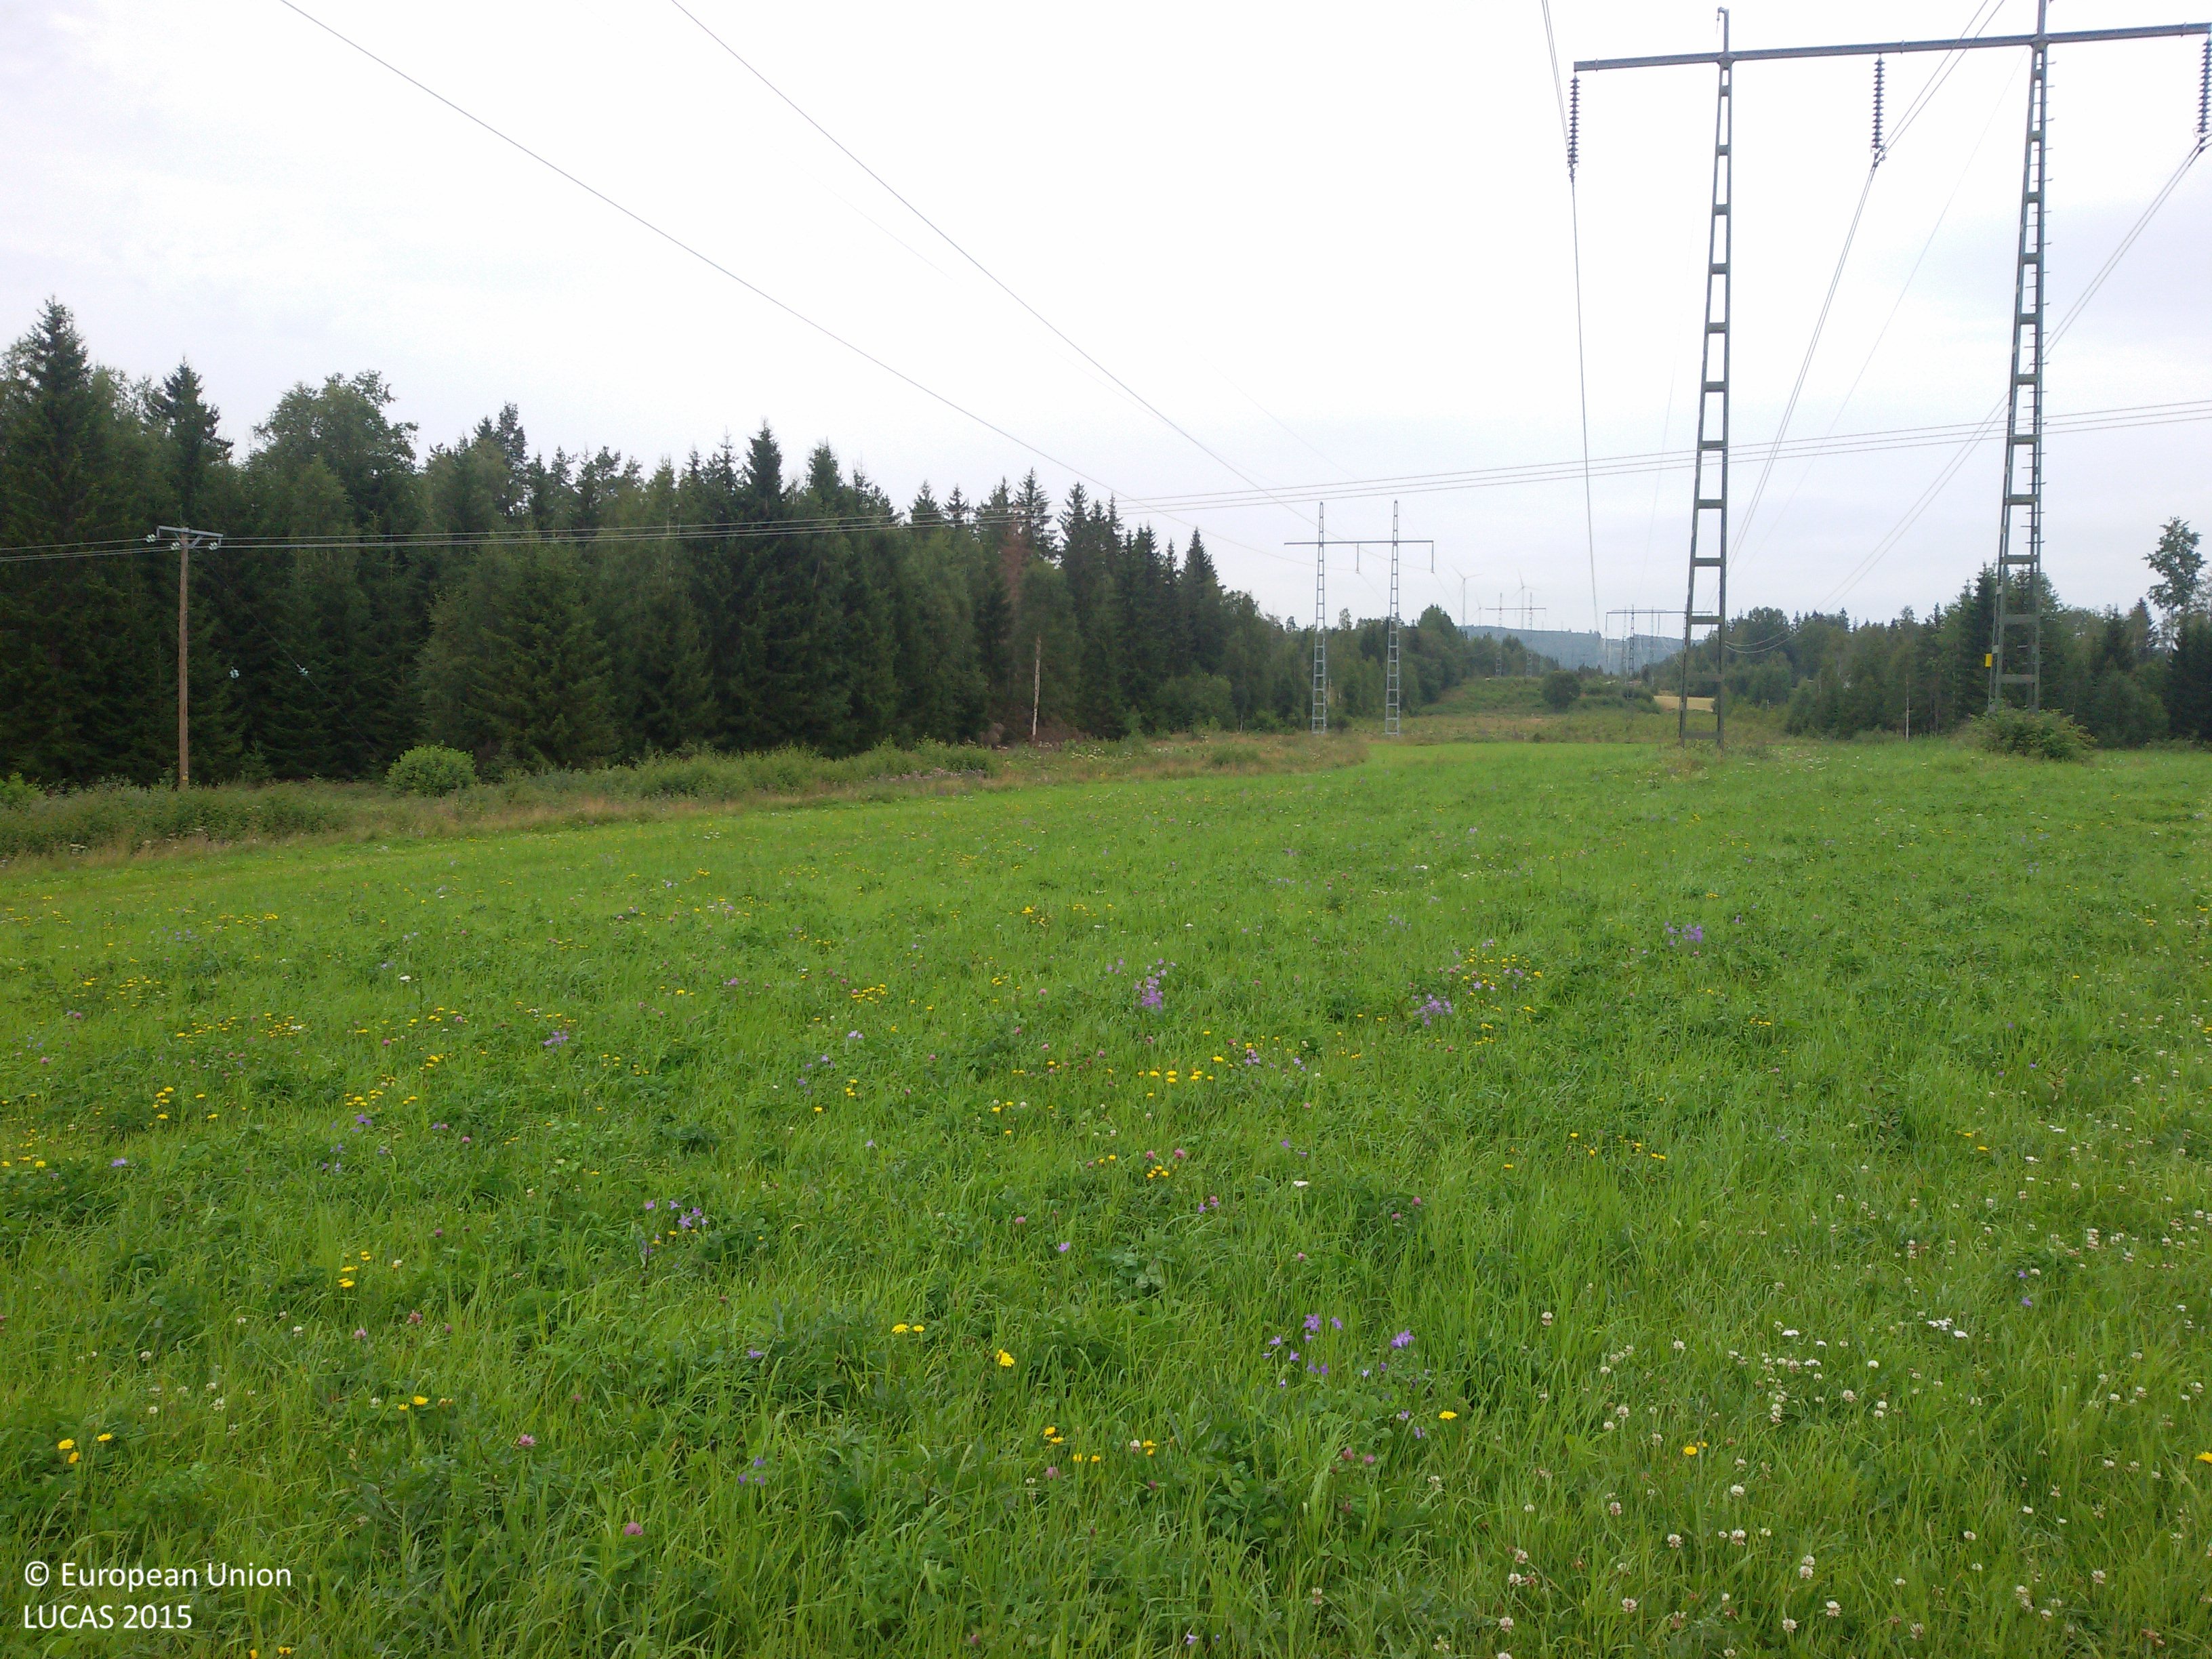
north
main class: Artificial land
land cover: Other artificial areas
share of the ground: > 75 %
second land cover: Grassland without tree/shrub cover
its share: > 75 %
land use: Electricity, gas and thermal power distribution
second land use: Agriculture (excluding fallow land and kitchen gardens)
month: August
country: SE
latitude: 60.7325
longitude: 16.5706
